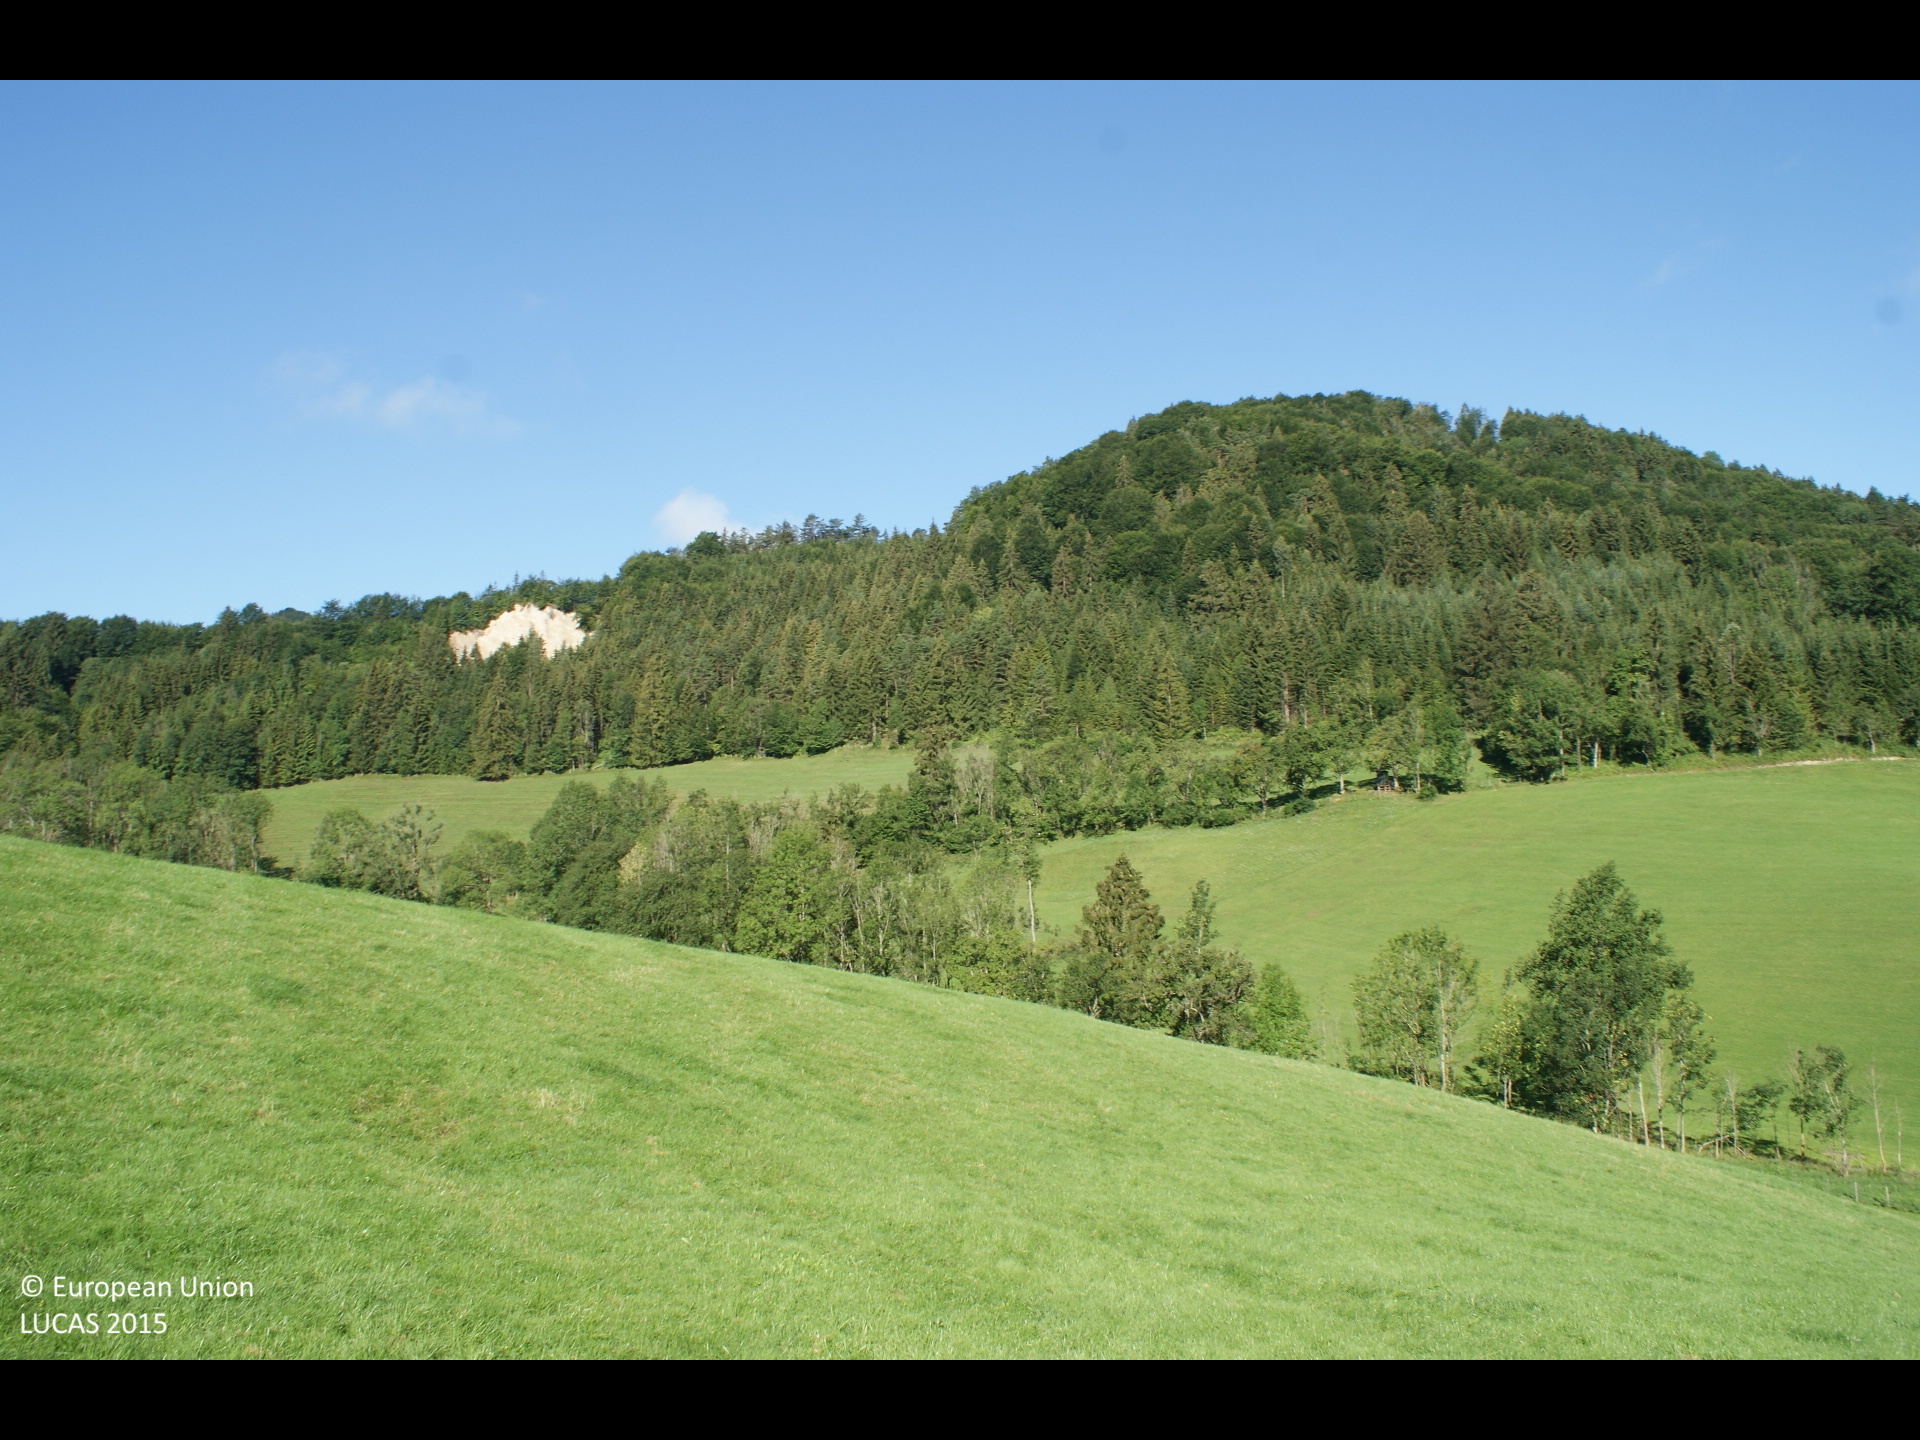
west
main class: Grassland
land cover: Grassland without tree/shrub cover
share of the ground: > 75 %
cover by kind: herbaceous plants 100 %
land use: Agriculture (excluding fallow land and kitchen gardens)
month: August
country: AT
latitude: 47.9205
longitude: 14.8045
